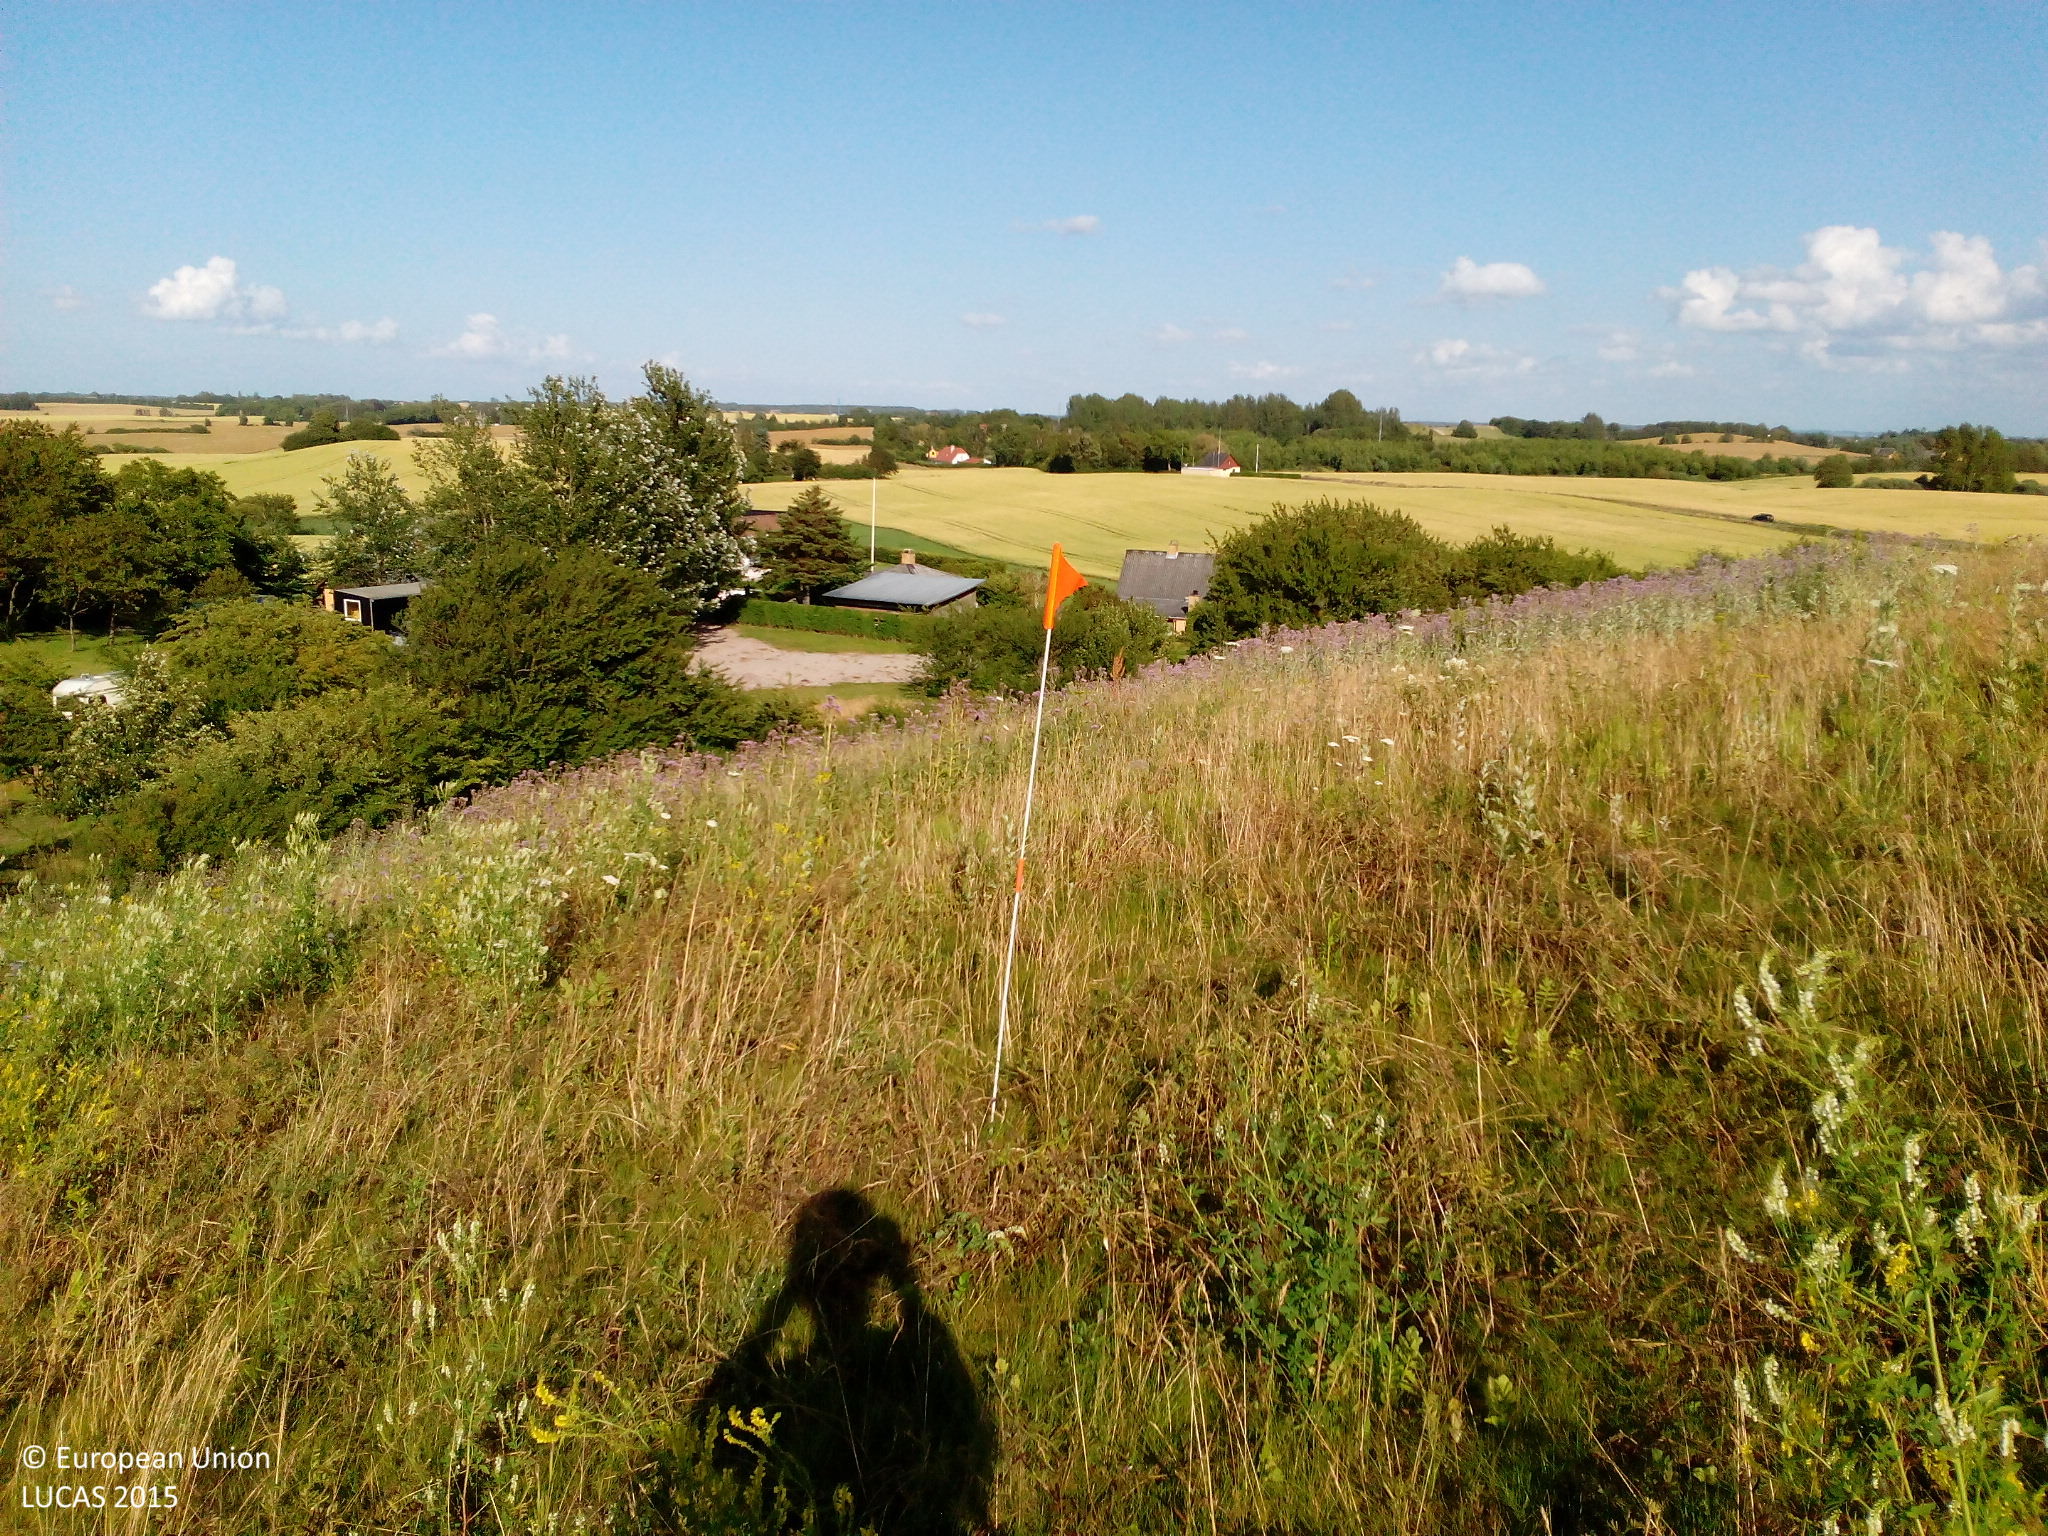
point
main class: Grassland
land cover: Spontaneously vegetated surfaces
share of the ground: > 75 %
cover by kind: herbaceous plants 100 %
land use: Fallow land
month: July
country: DK
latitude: 55.8548
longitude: 11.5480
